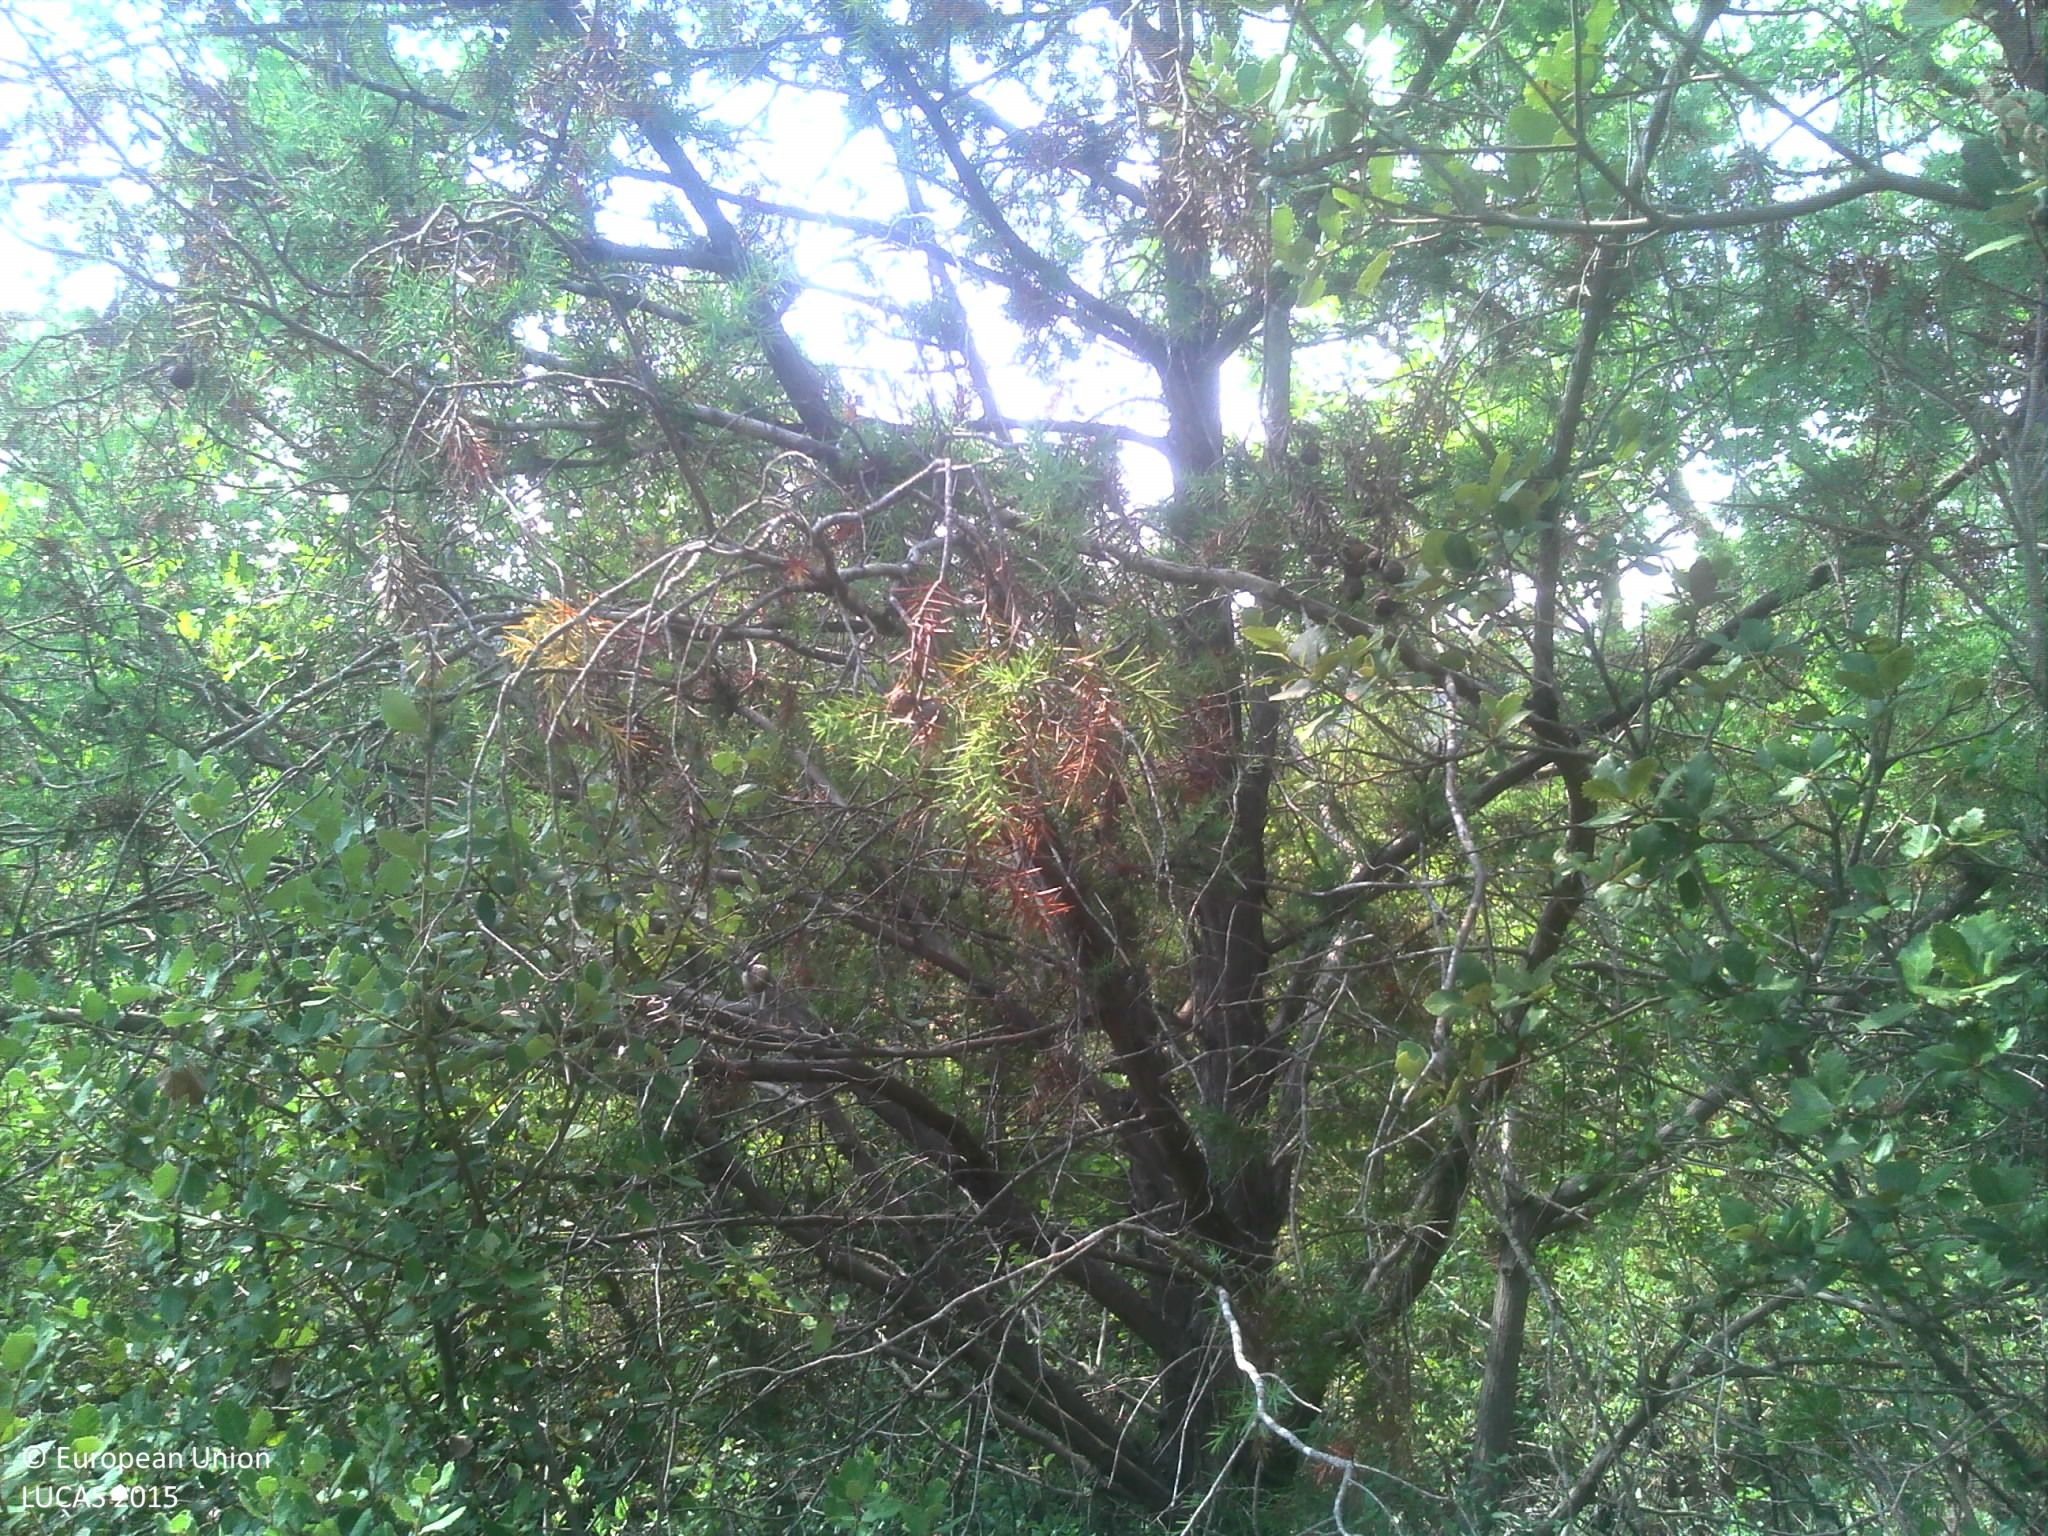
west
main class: Woodland
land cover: Pine dominated mixed woodland
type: coniferous forest of the mediterranean region
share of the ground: > 75 %
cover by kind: broadleaved forest trees 40 %, coniferous forest trees 35 %, shrubs 20 %, herbaceous plants 5 %
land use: Semi-natural and natural areas not in use
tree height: > 5 m
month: July
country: FR
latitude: 43.4561
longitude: 6.3630
